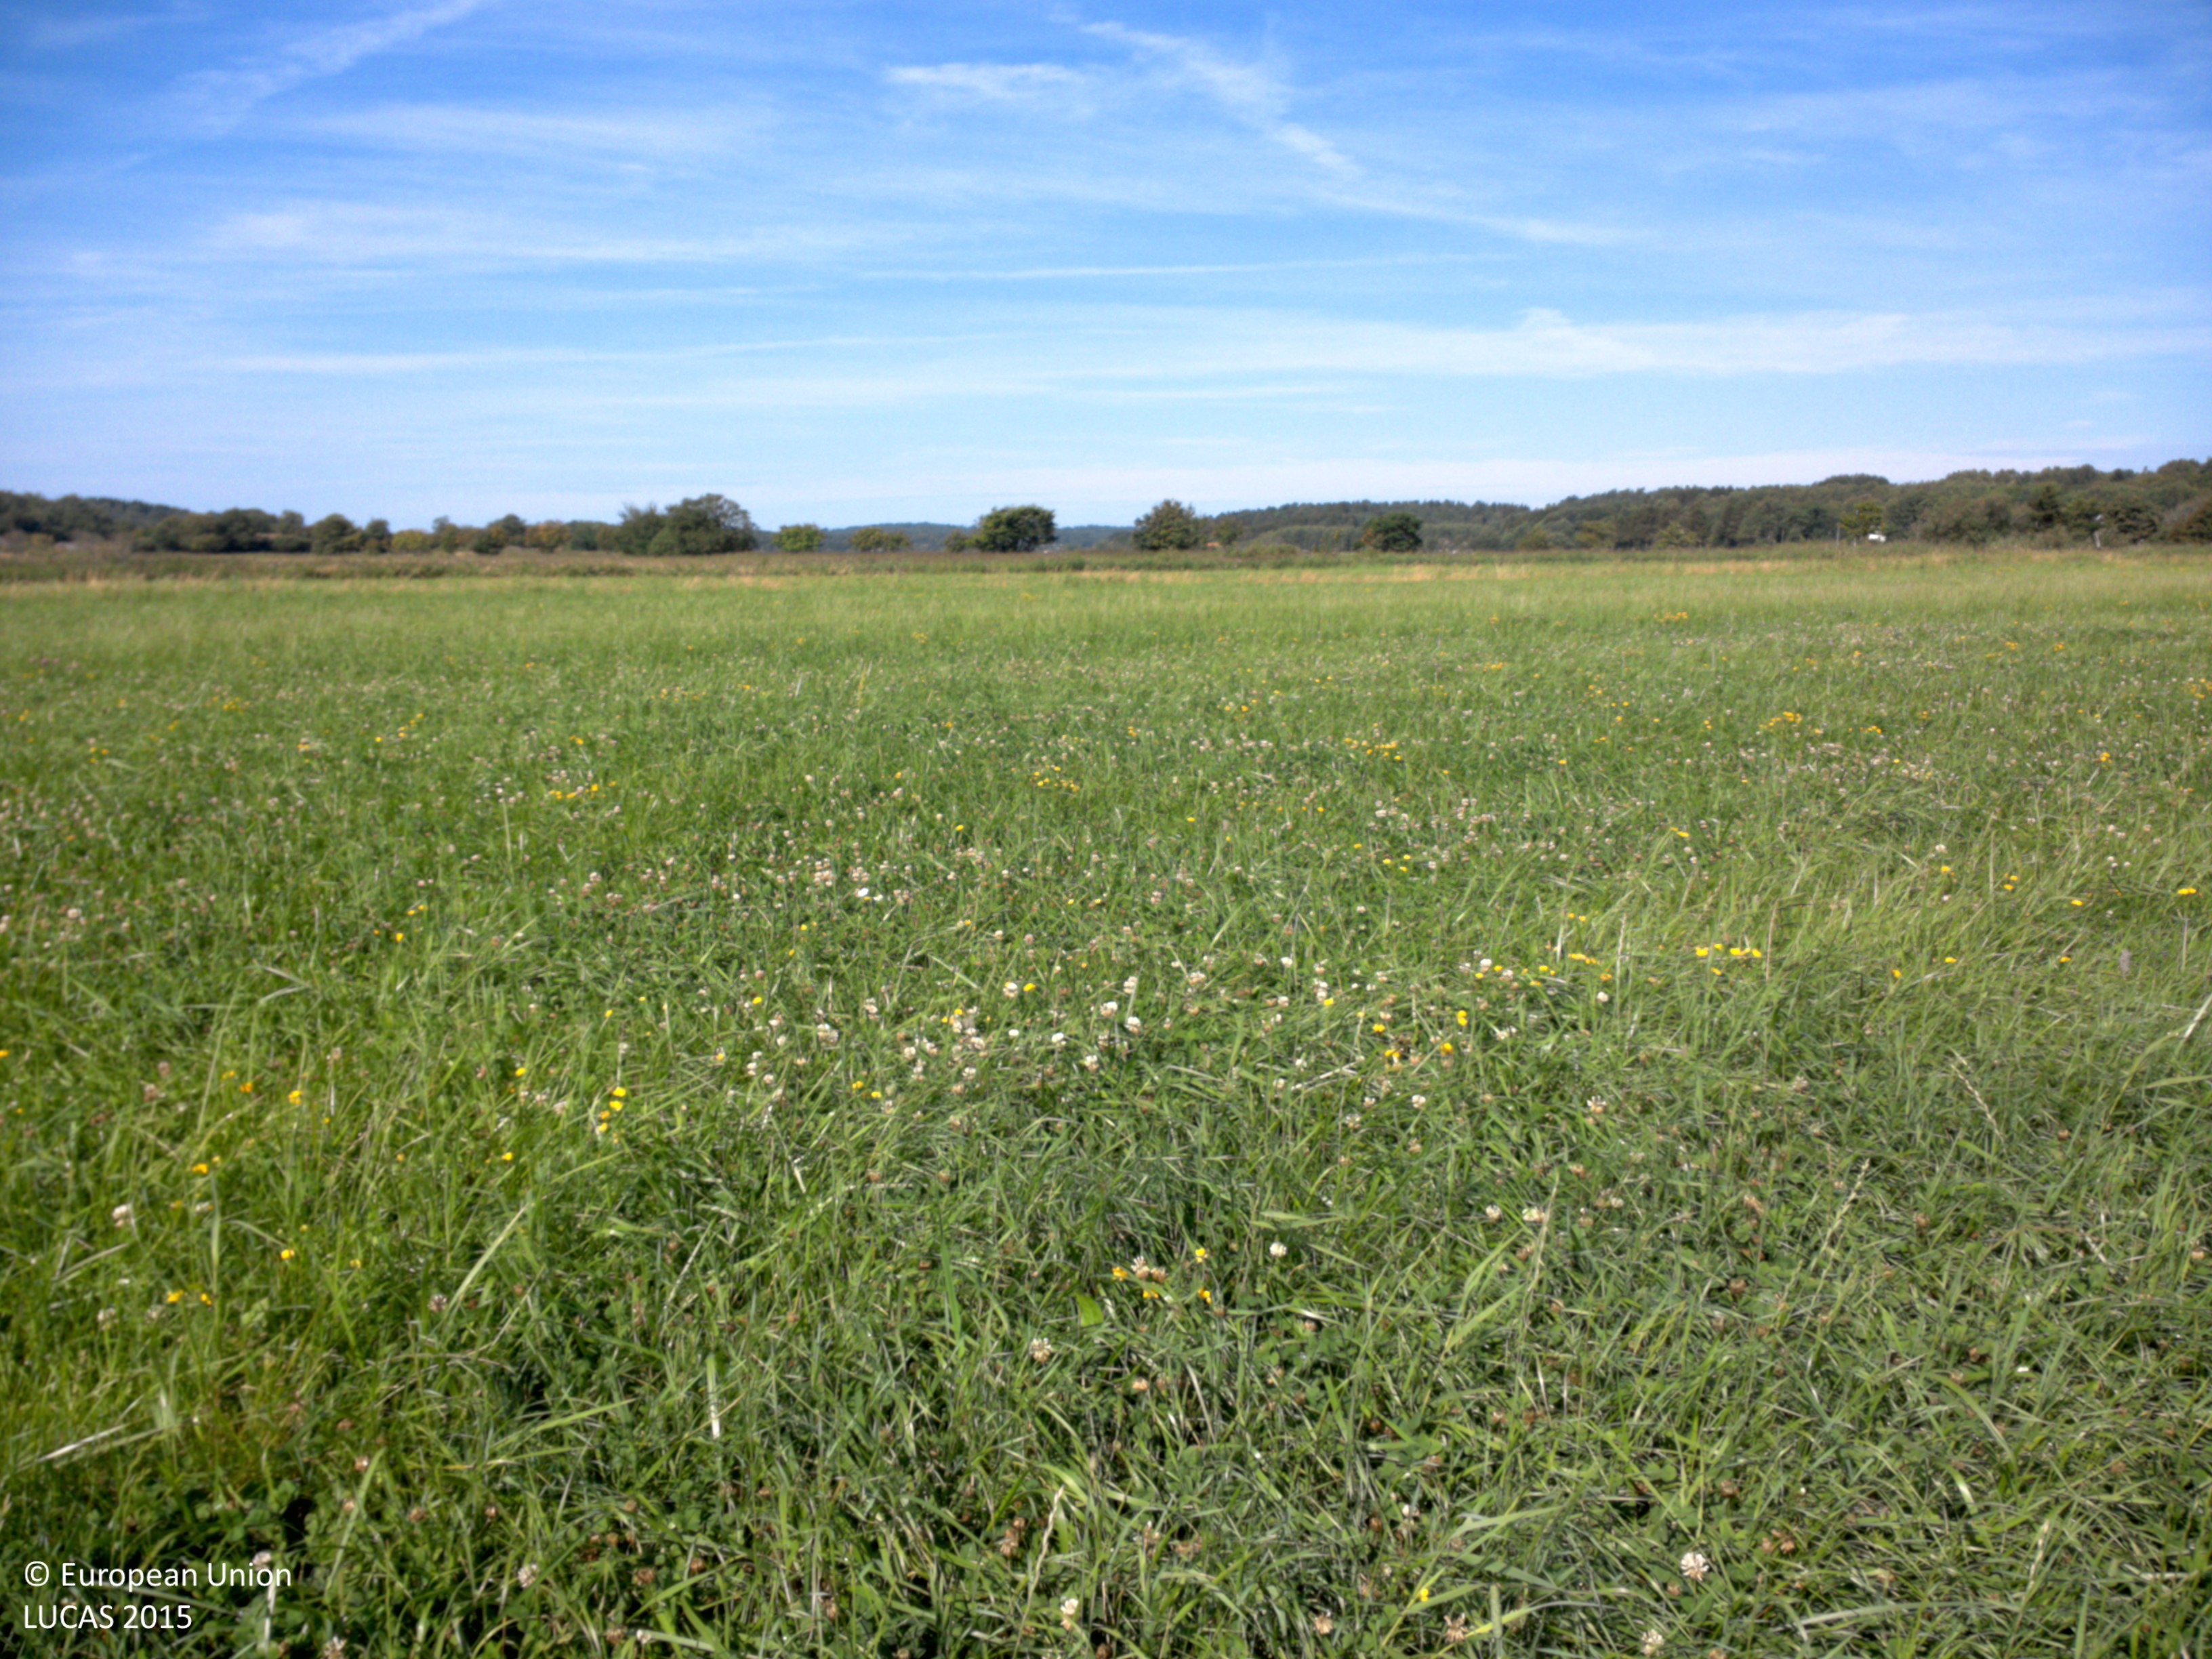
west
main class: Cropland
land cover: Temporary grasslands
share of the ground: > 75 %
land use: Agriculture (excluding fallow land and kitchen gardens)
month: August
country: SE
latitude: 57.8292
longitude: 11.8322
